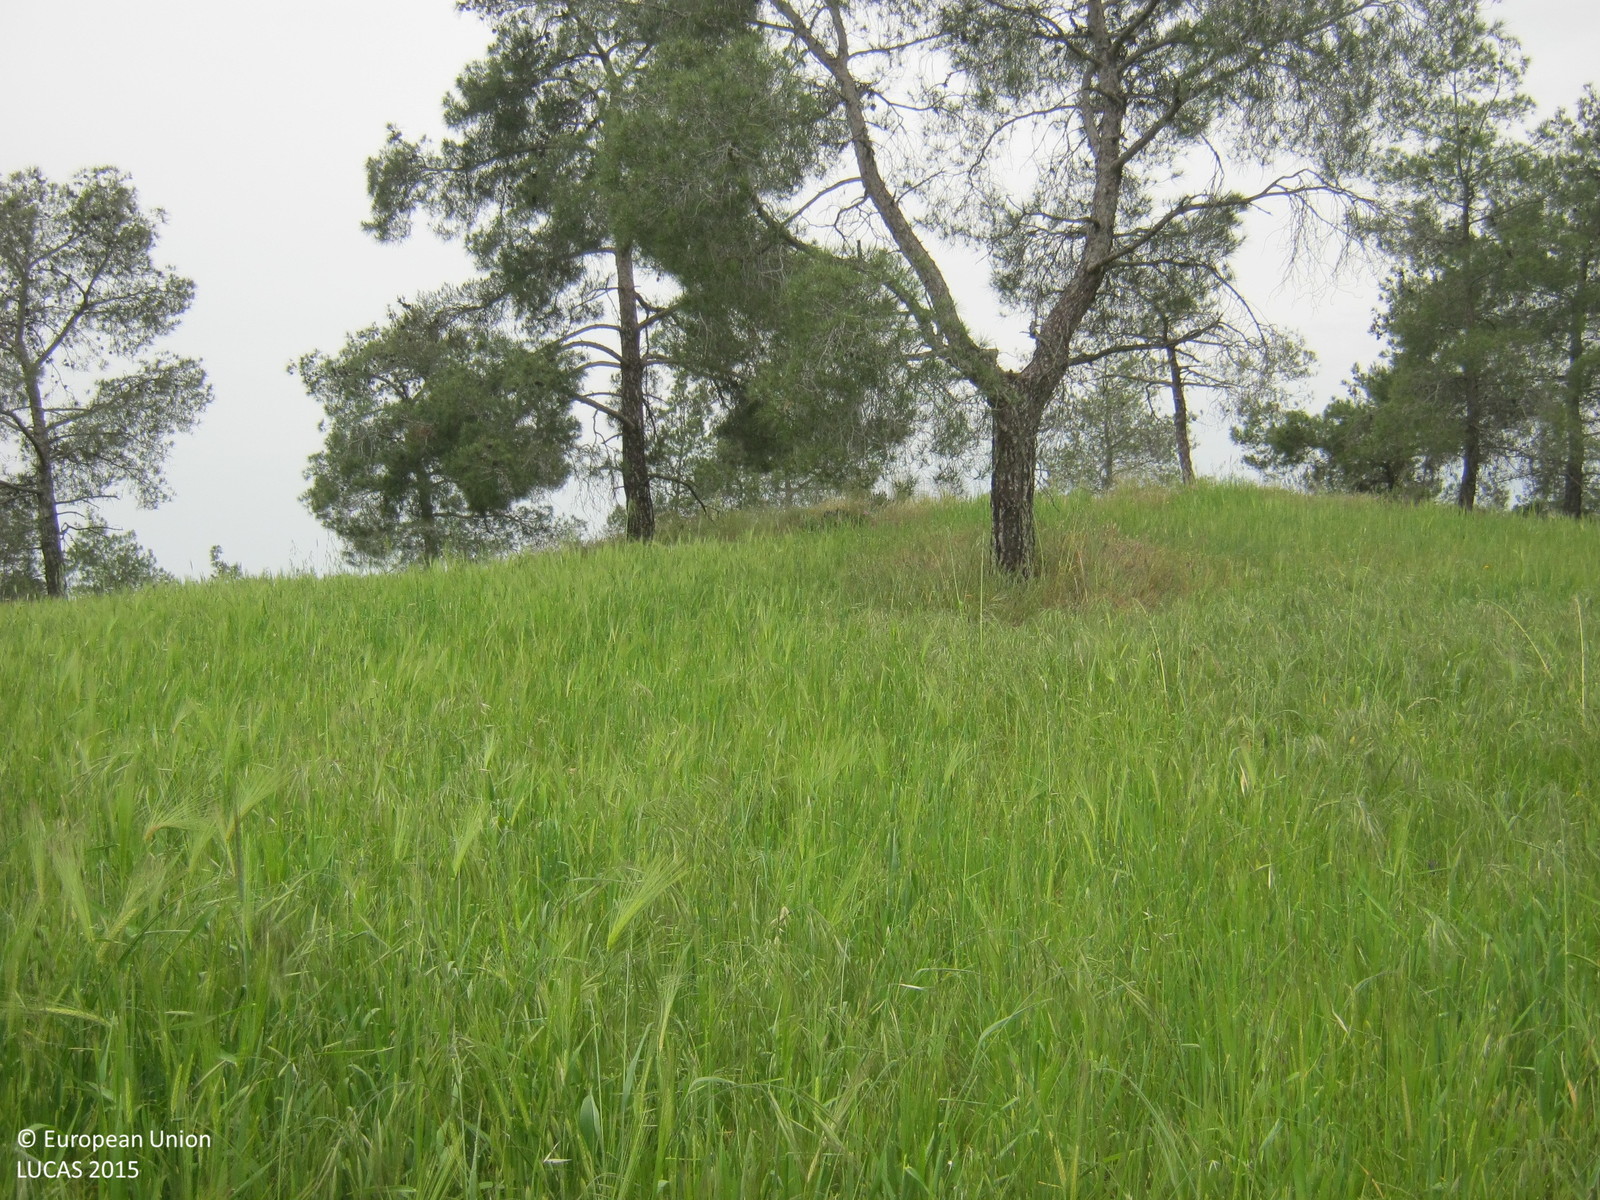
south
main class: Cropland
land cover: Common wheat
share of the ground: > 75 %
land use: Agriculture (excluding fallow land and kitchen gardens)
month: April
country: CY
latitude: 34.9263
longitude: 33.3604
